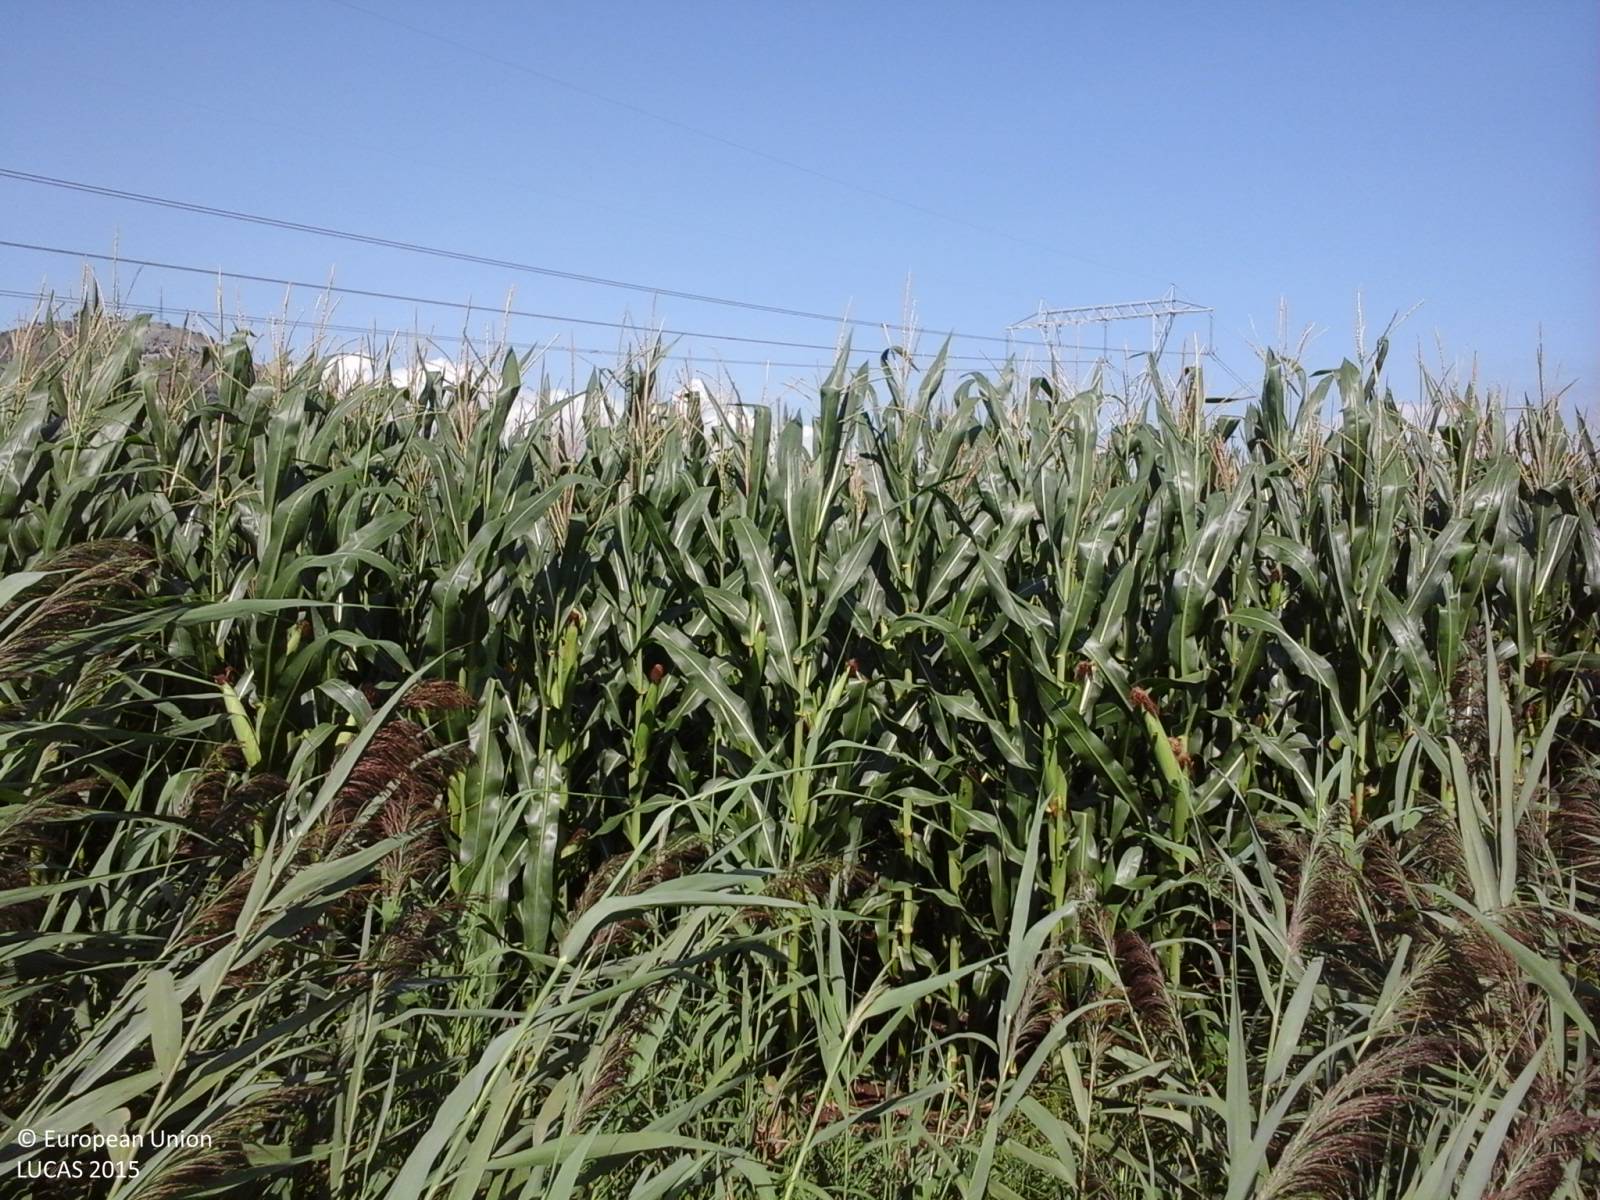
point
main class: Cropland
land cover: Maize
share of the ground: > 75 %
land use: Agriculture (excluding fallow land and kitchen gardens)
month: August
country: IT
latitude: 41.4685
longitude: 13.0651
